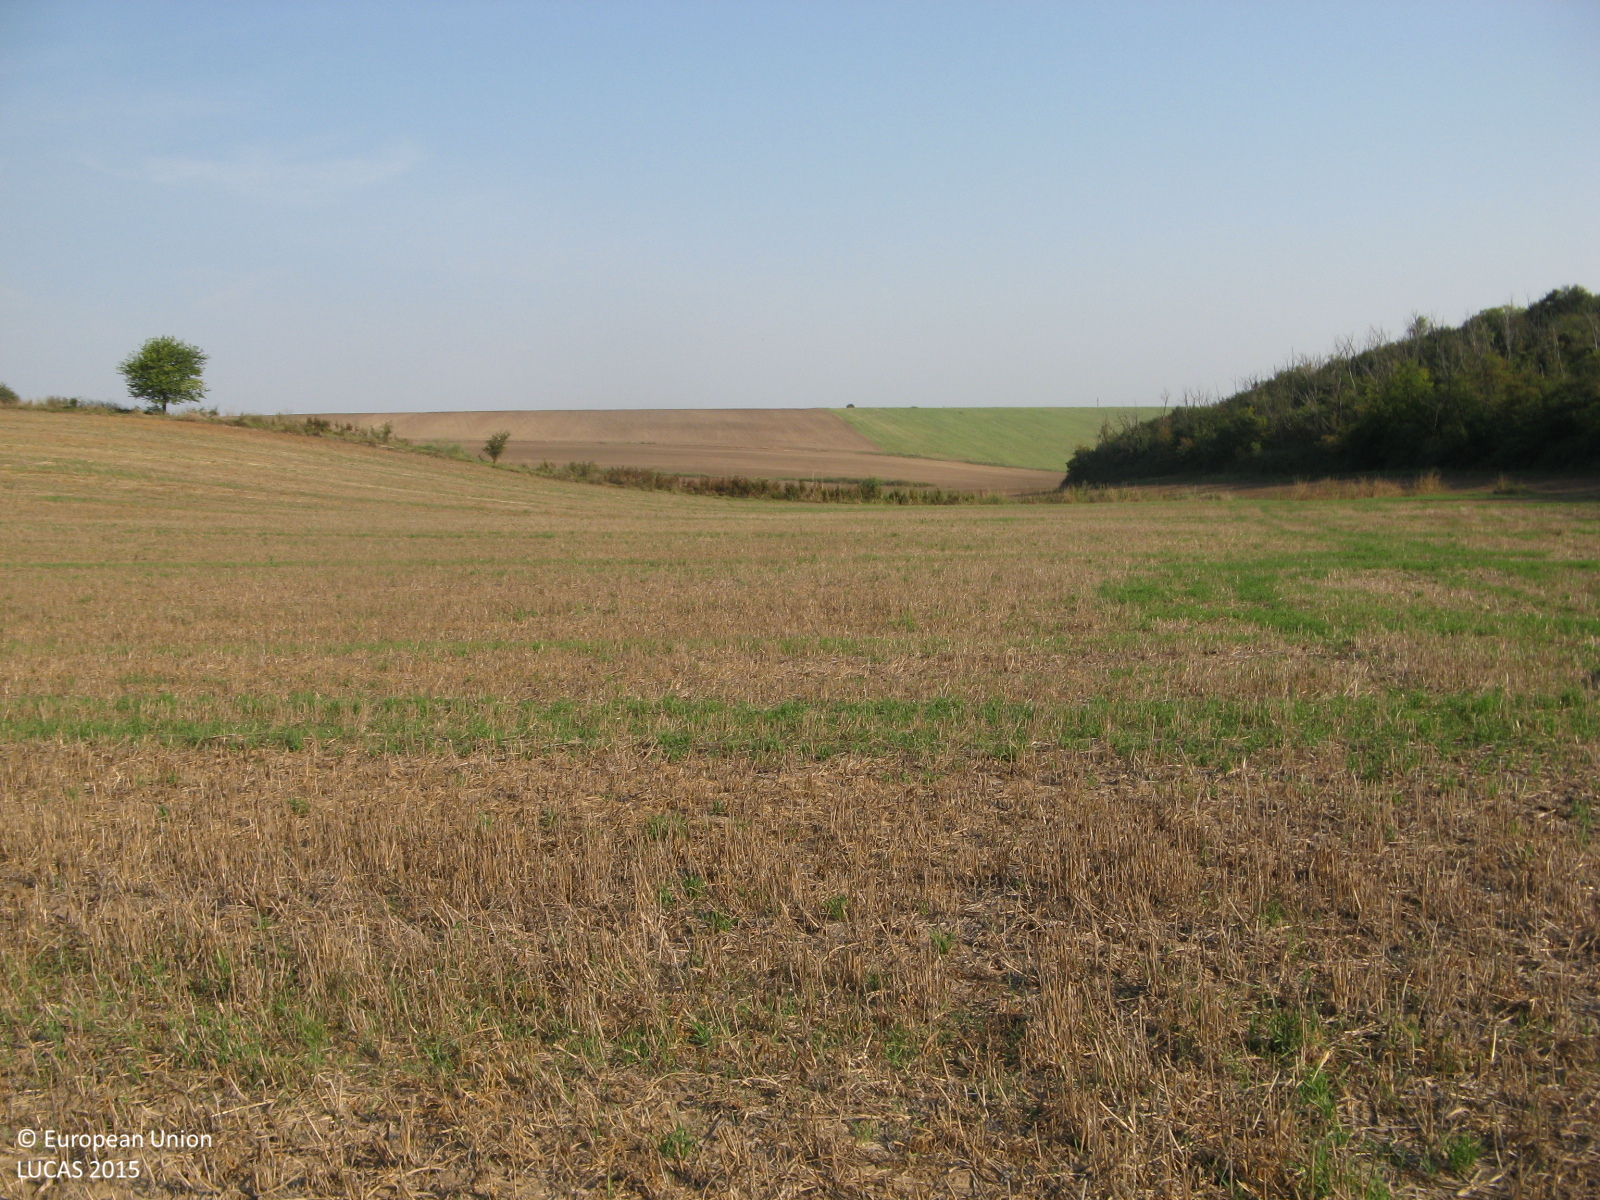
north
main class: Cropland
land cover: Common wheat
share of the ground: 25 - 50 %
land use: Agriculture (excluding fallow land and kitchen gardens)
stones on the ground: < 10 %
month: September
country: BG
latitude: 43.7531
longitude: 25.9287
